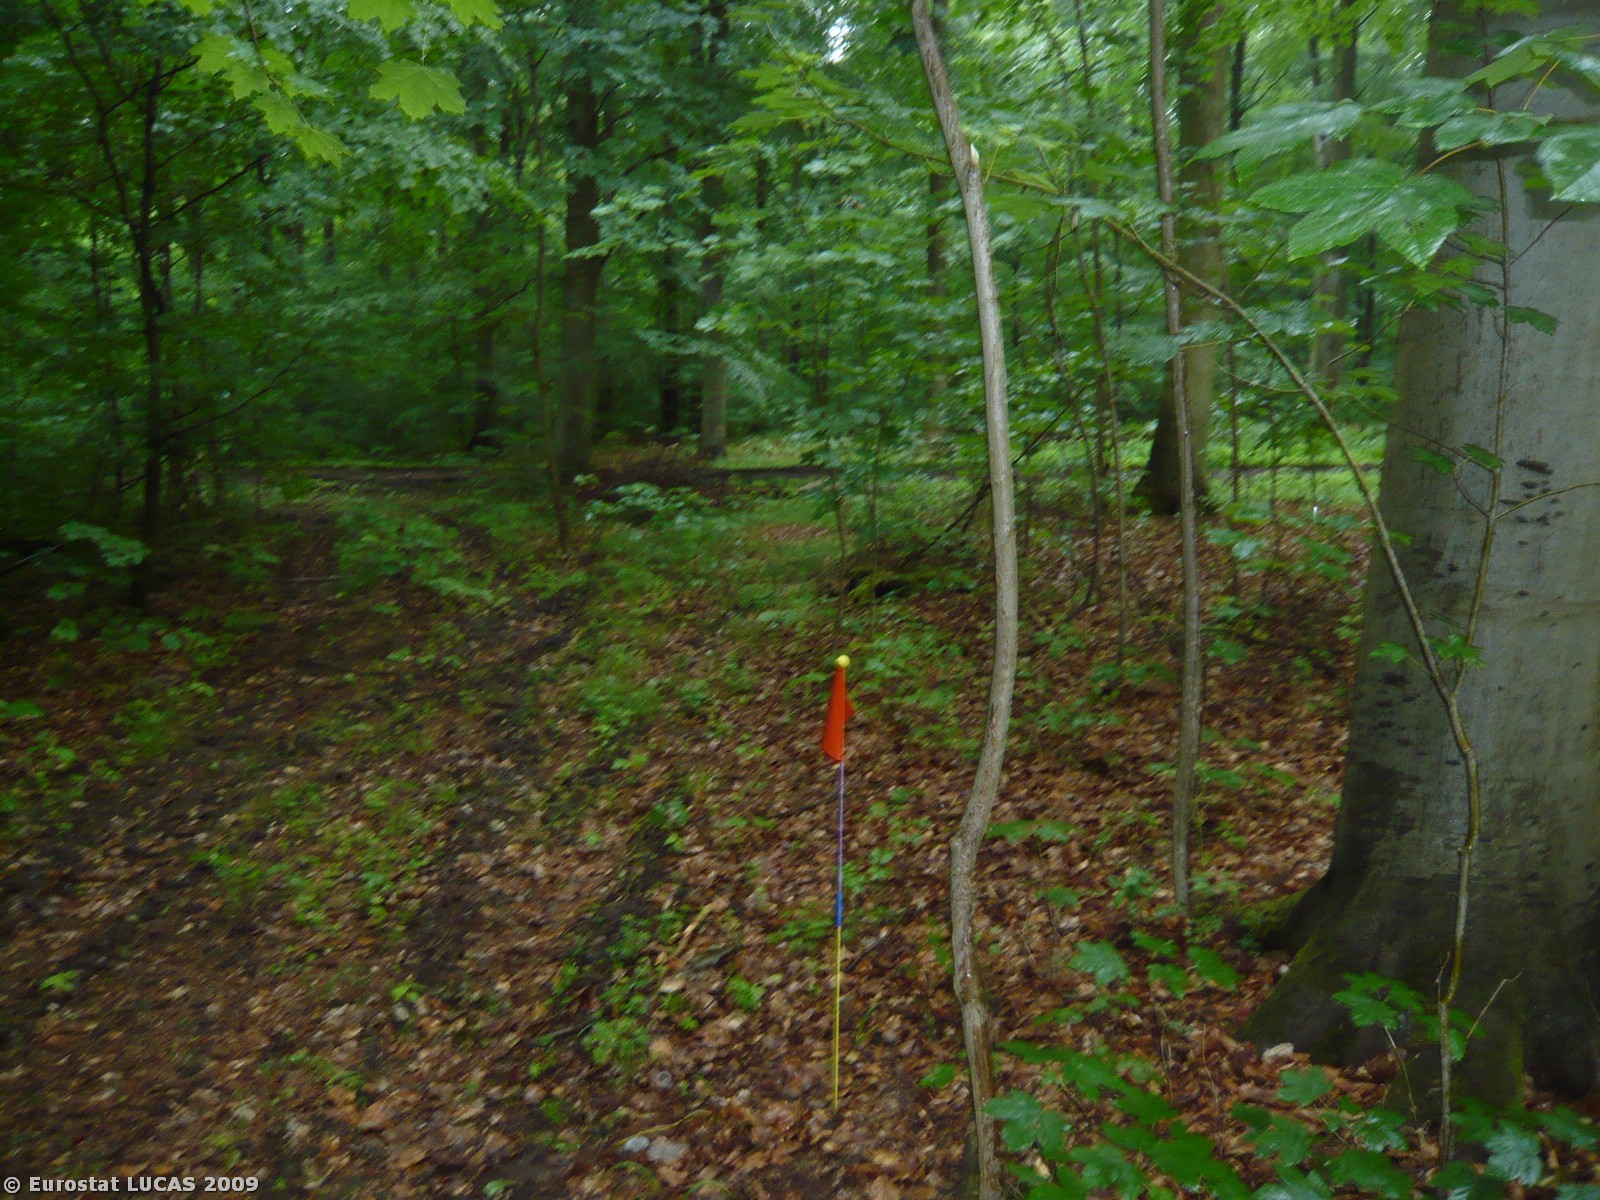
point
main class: Woodland
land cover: Broadleaved woodland
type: mesophytic deciduous forest
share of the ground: > 75 %
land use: Forestry
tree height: > 5 m
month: June
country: DK
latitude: 54.8255
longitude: 11.8822
